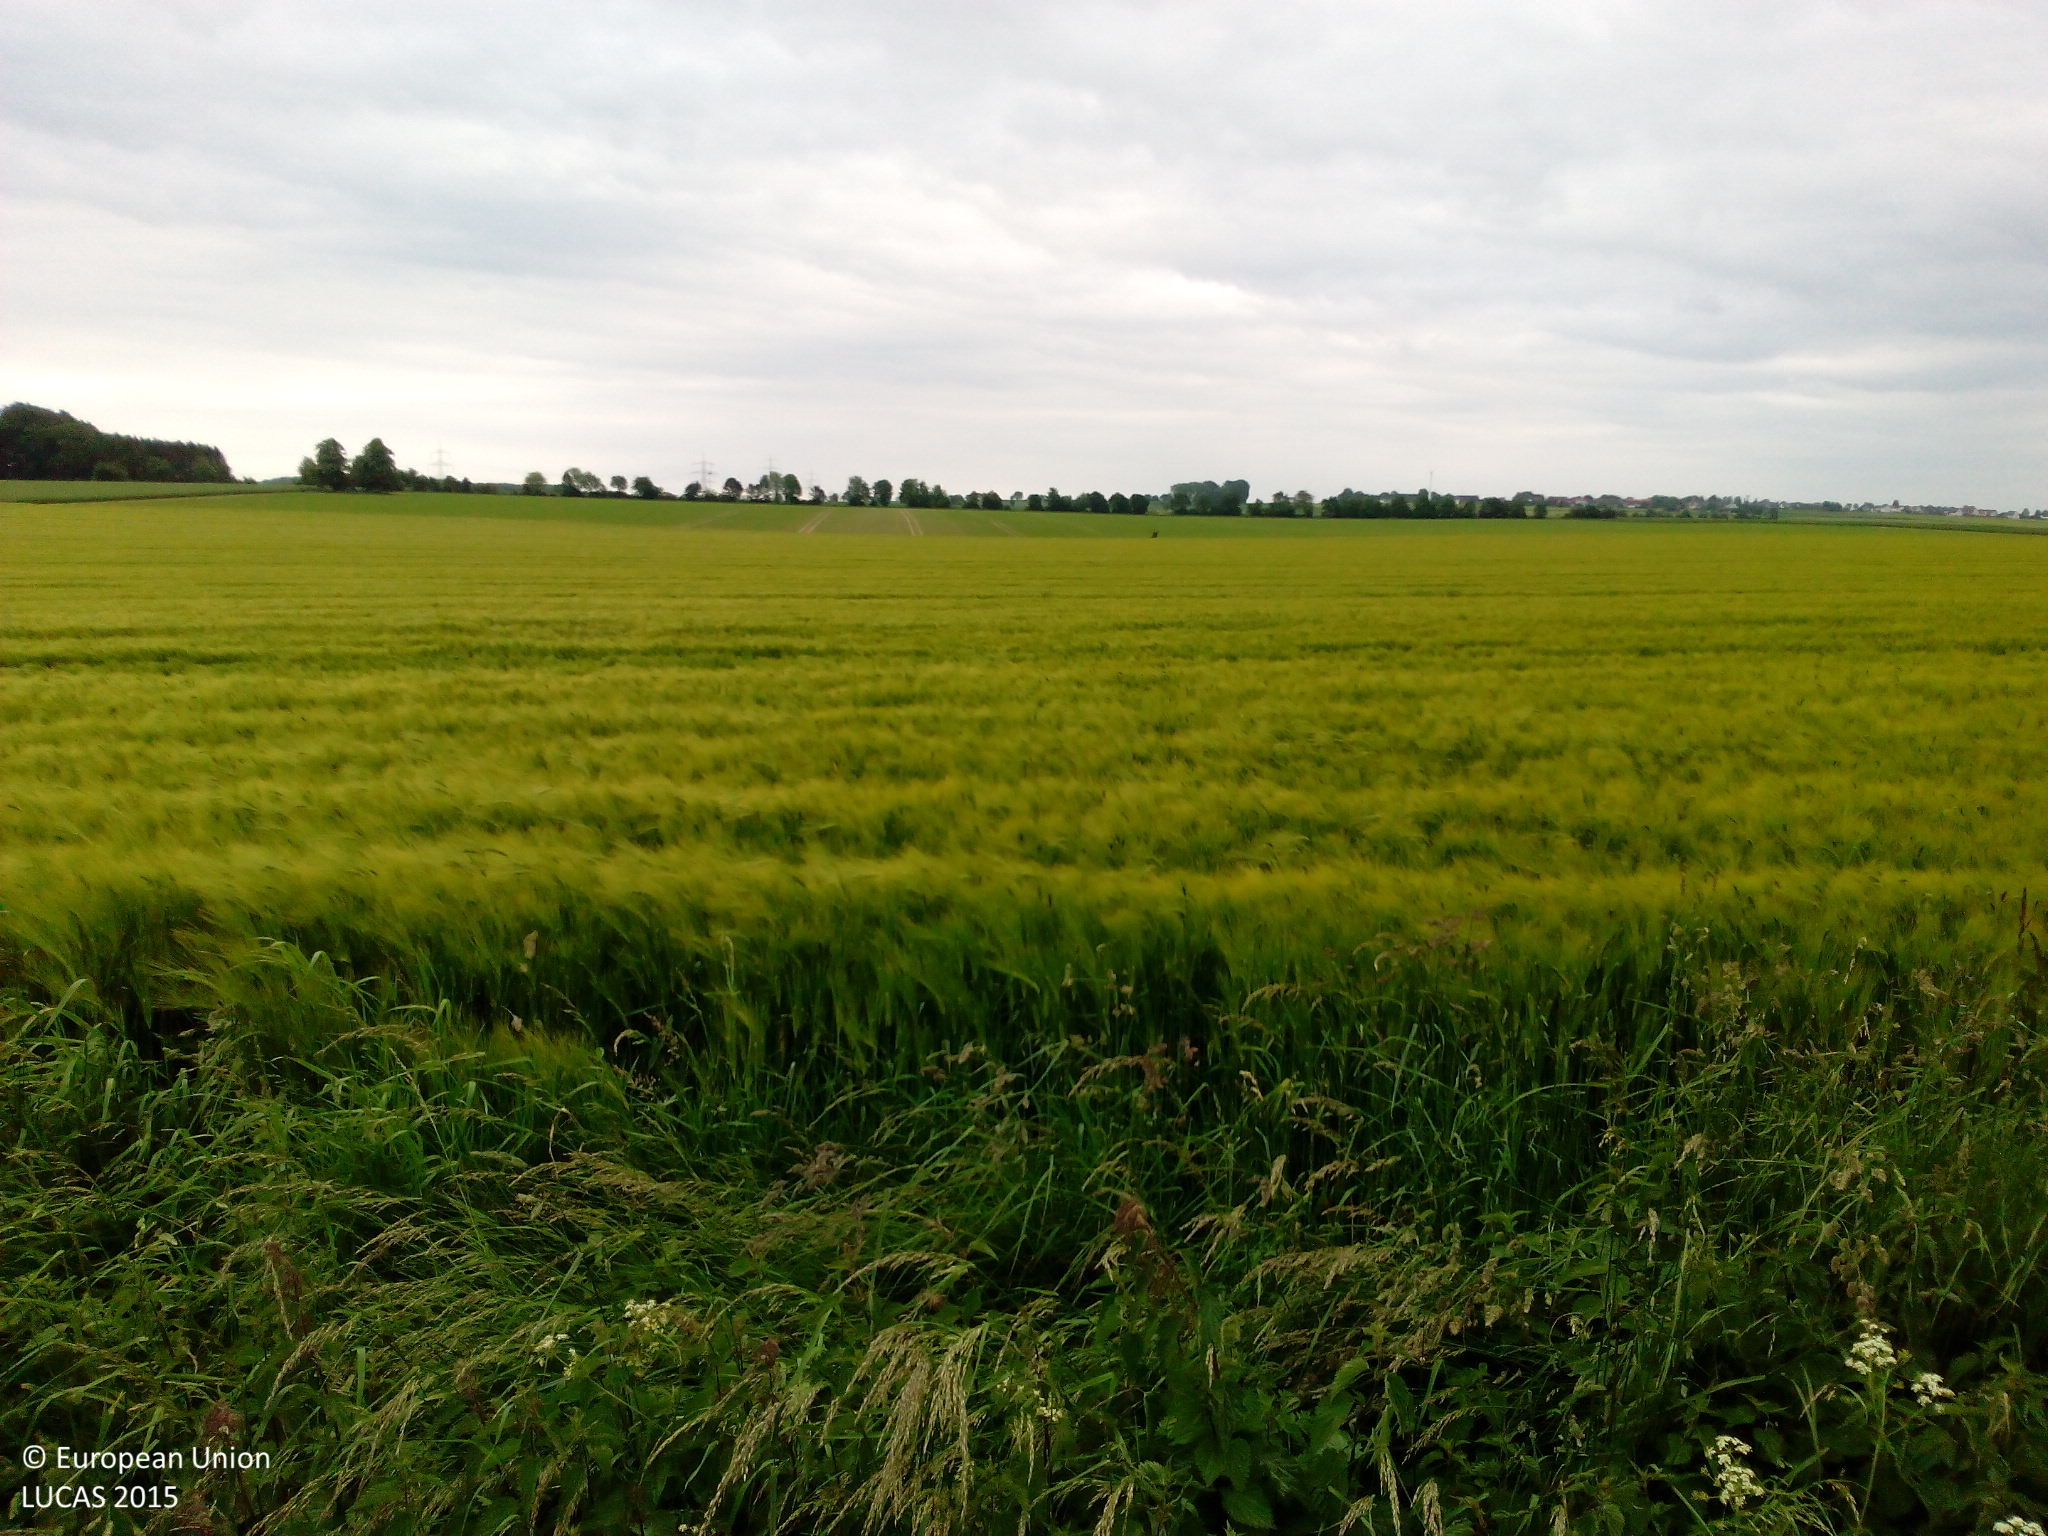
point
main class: Cropland
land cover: Barley
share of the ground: > 75 %
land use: Agriculture (excluding fallow land and kitchen gardens)
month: June
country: DE
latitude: 51.5330
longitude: 7.9677
